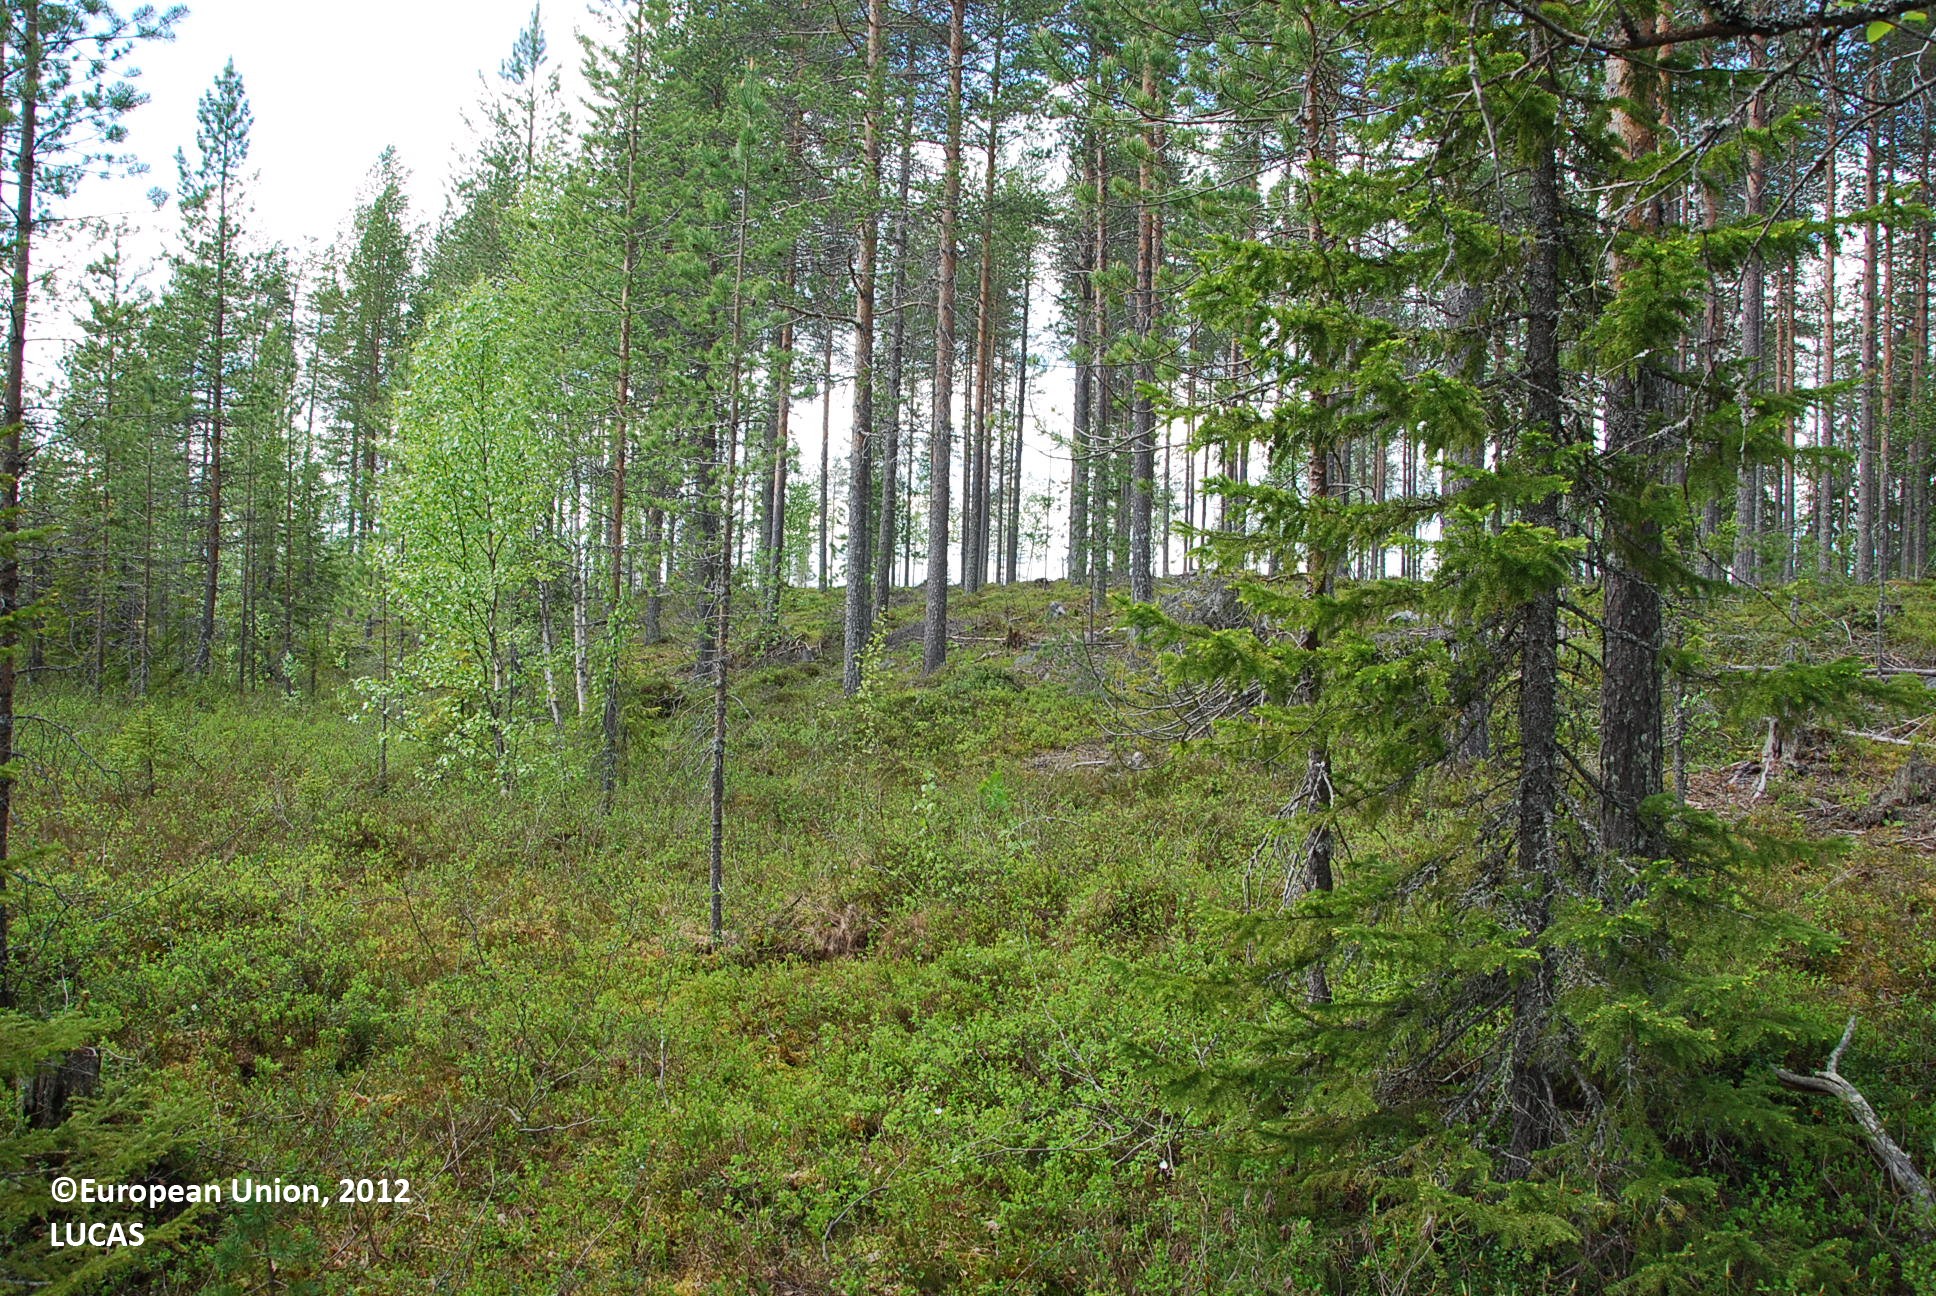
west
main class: Woodland
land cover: Pine dominated coniferous woodland
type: boreal forest
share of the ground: > 75 %
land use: Forestry
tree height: > 5 m
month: June
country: FI
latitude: 65.9762
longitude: 27.3994
